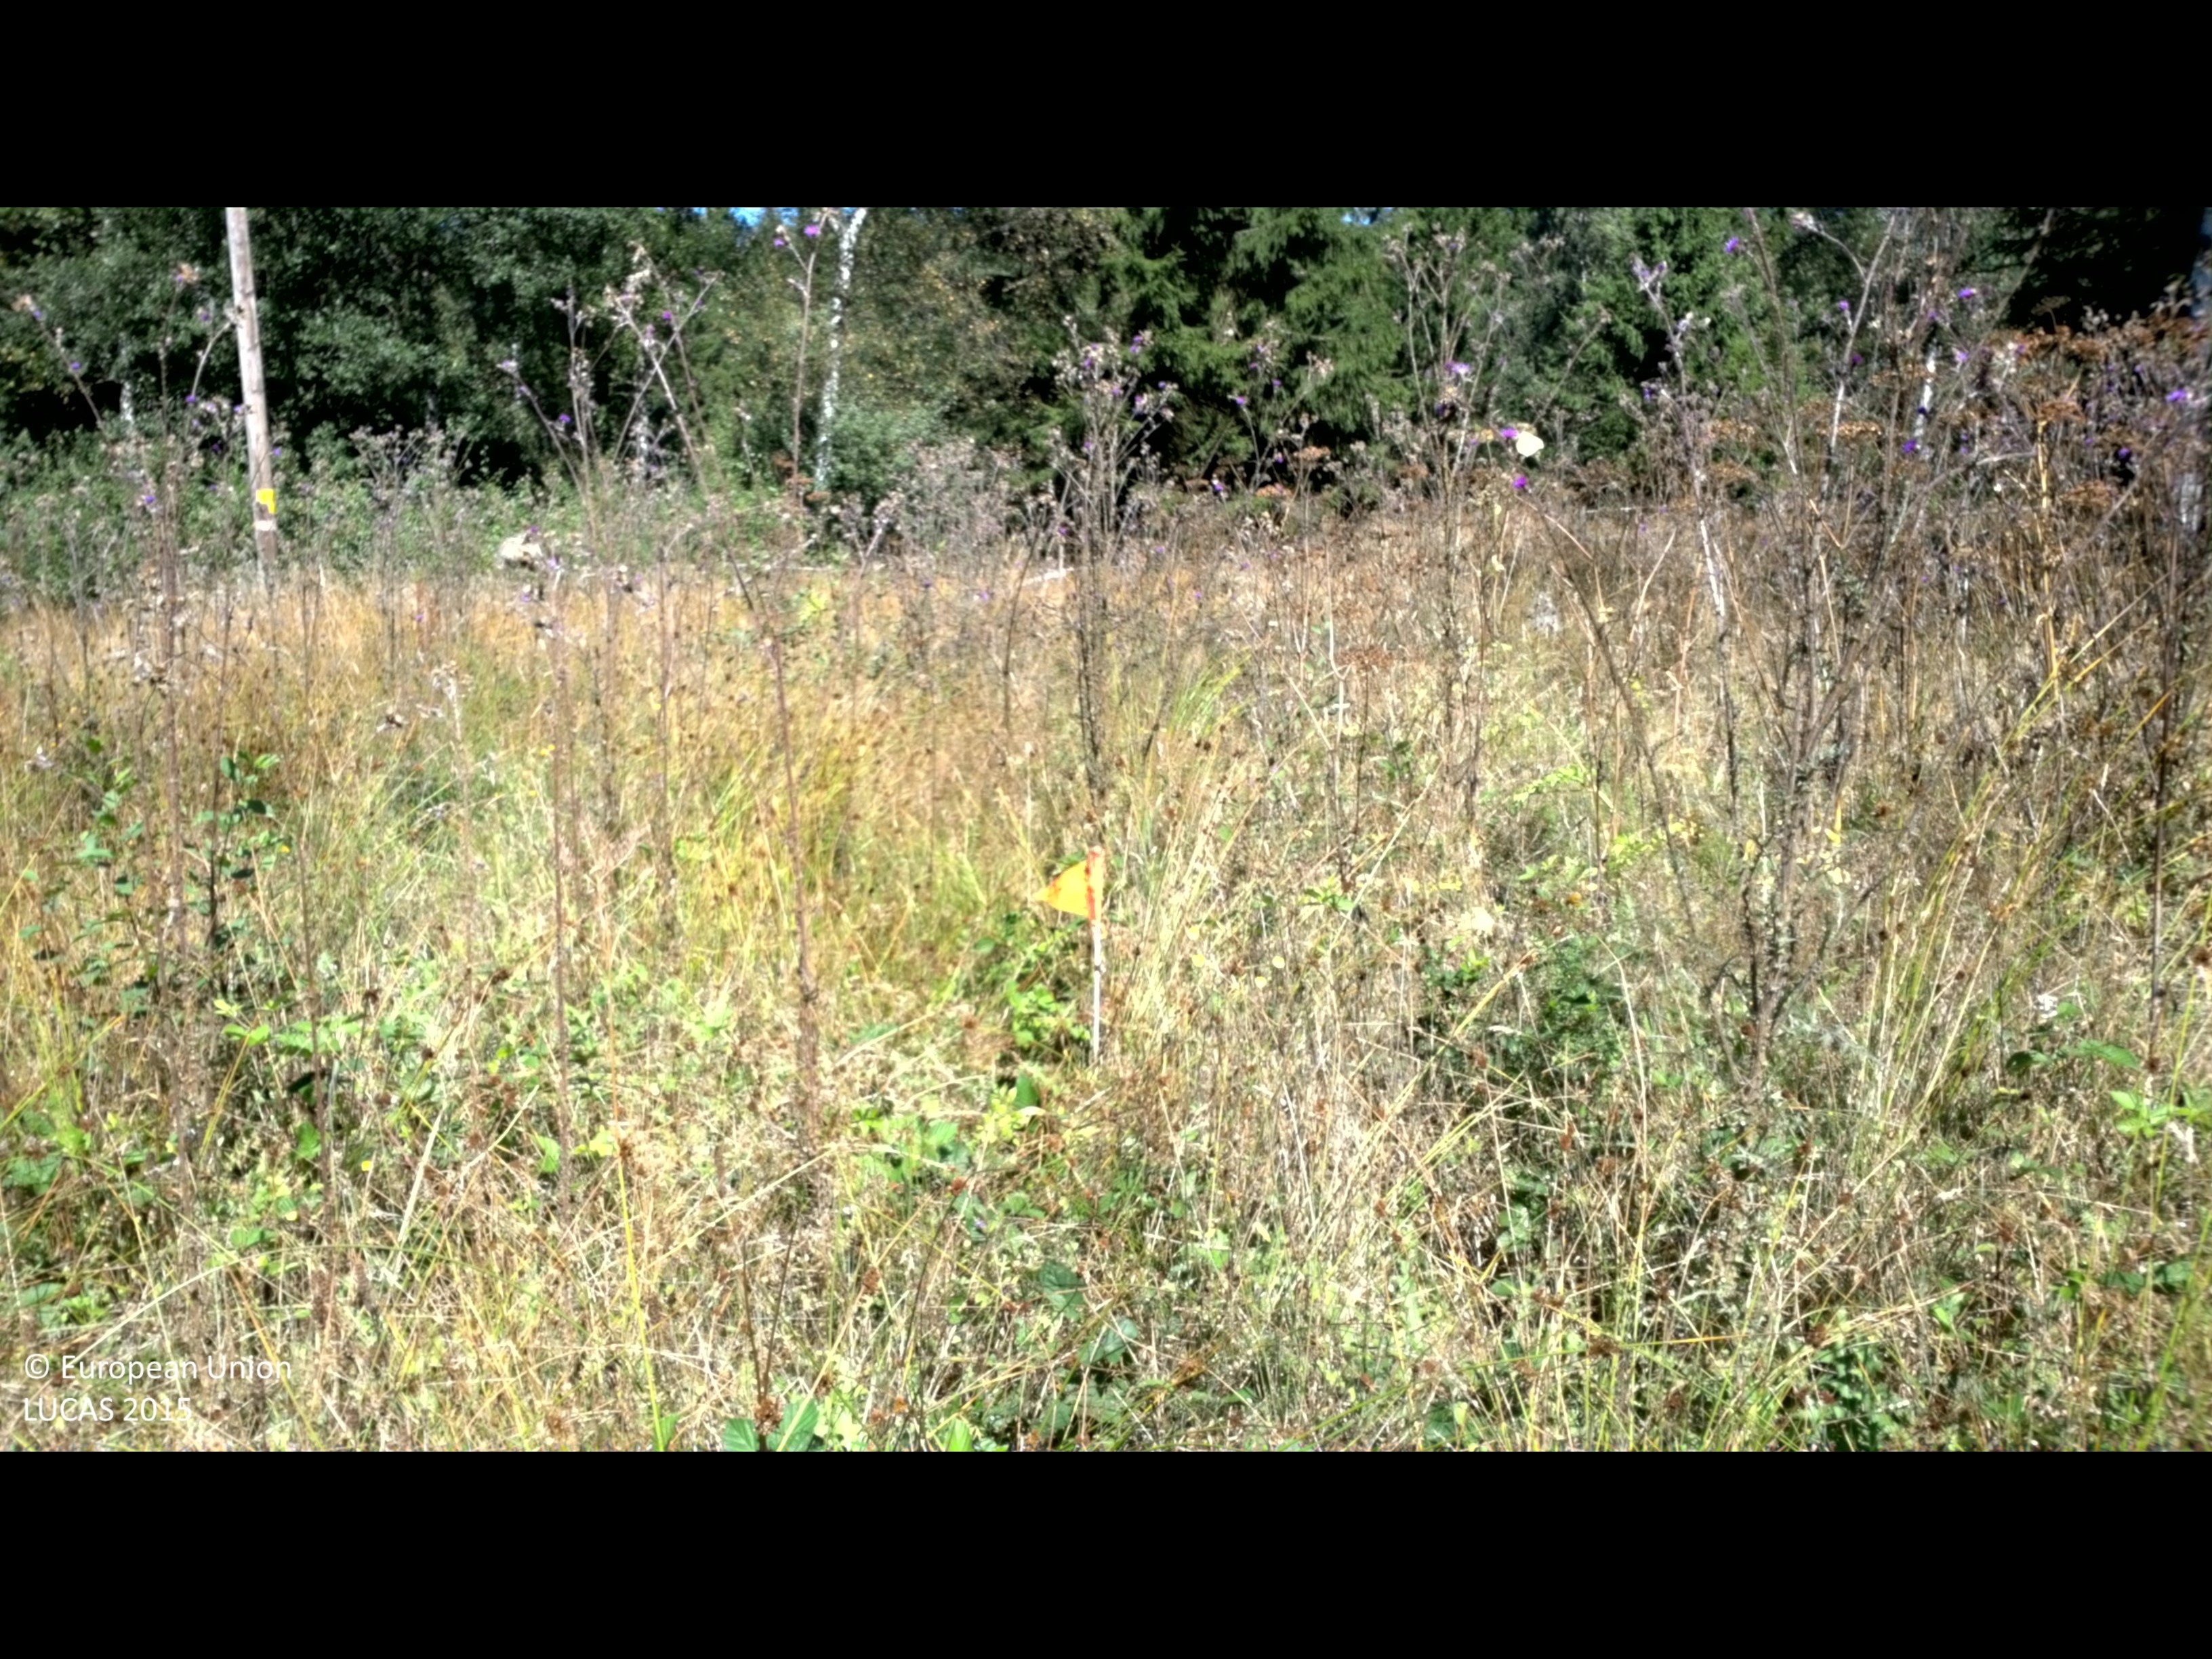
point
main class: Grassland
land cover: Grassland without tree/shrub cover
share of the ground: > 75 %
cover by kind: herbaceous plants 100 %
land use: Semi-natural and natural areas not in use
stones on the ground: < 10 %
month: August
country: SE
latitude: 56.1613
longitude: 15.8778
